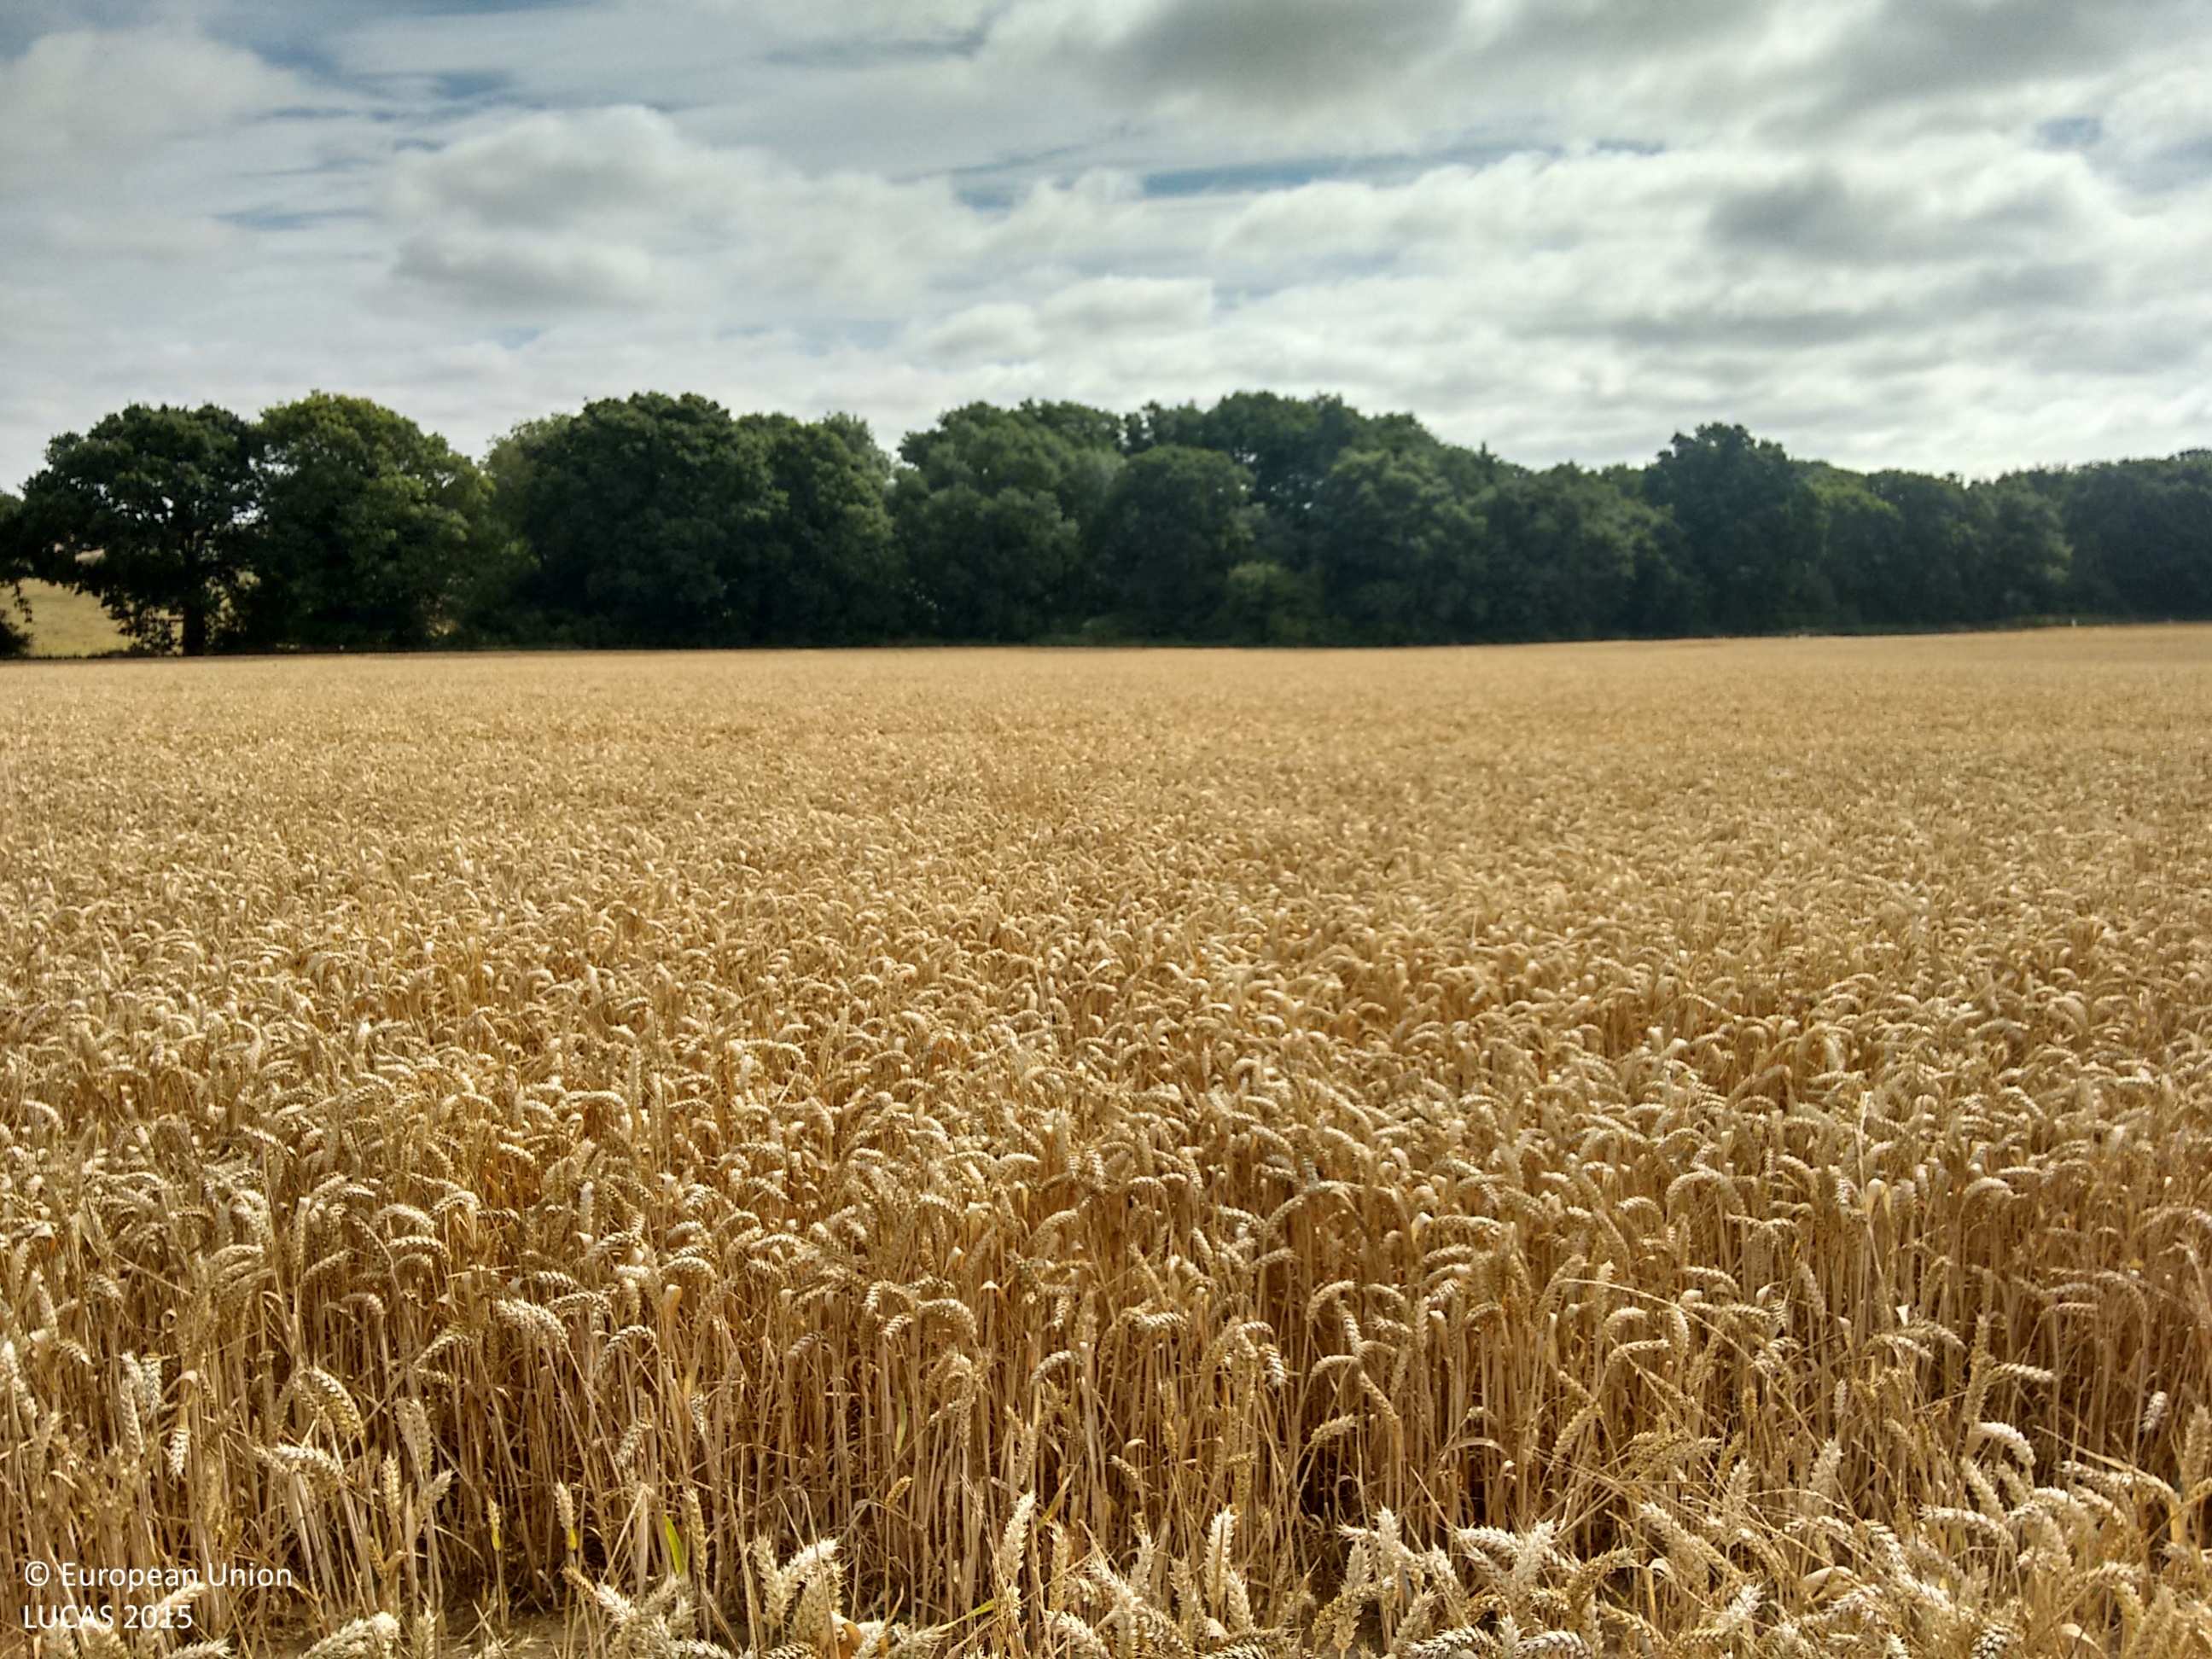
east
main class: Cropland
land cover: Common wheat
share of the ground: > 75 %
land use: Agriculture (excluding fallow land and kitchen gardens)
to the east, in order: Common wheat; Grass margins; Broadleaved woodland; Inland fresh water bodies; Broadleaved woodland; Inland fresh running water; Broadleaved woodland; Fences; Grassland without tree/shrub cover; Tracks; Grassland without tree/shrub cover
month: August
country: GB
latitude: 51.8400
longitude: 1.0510
